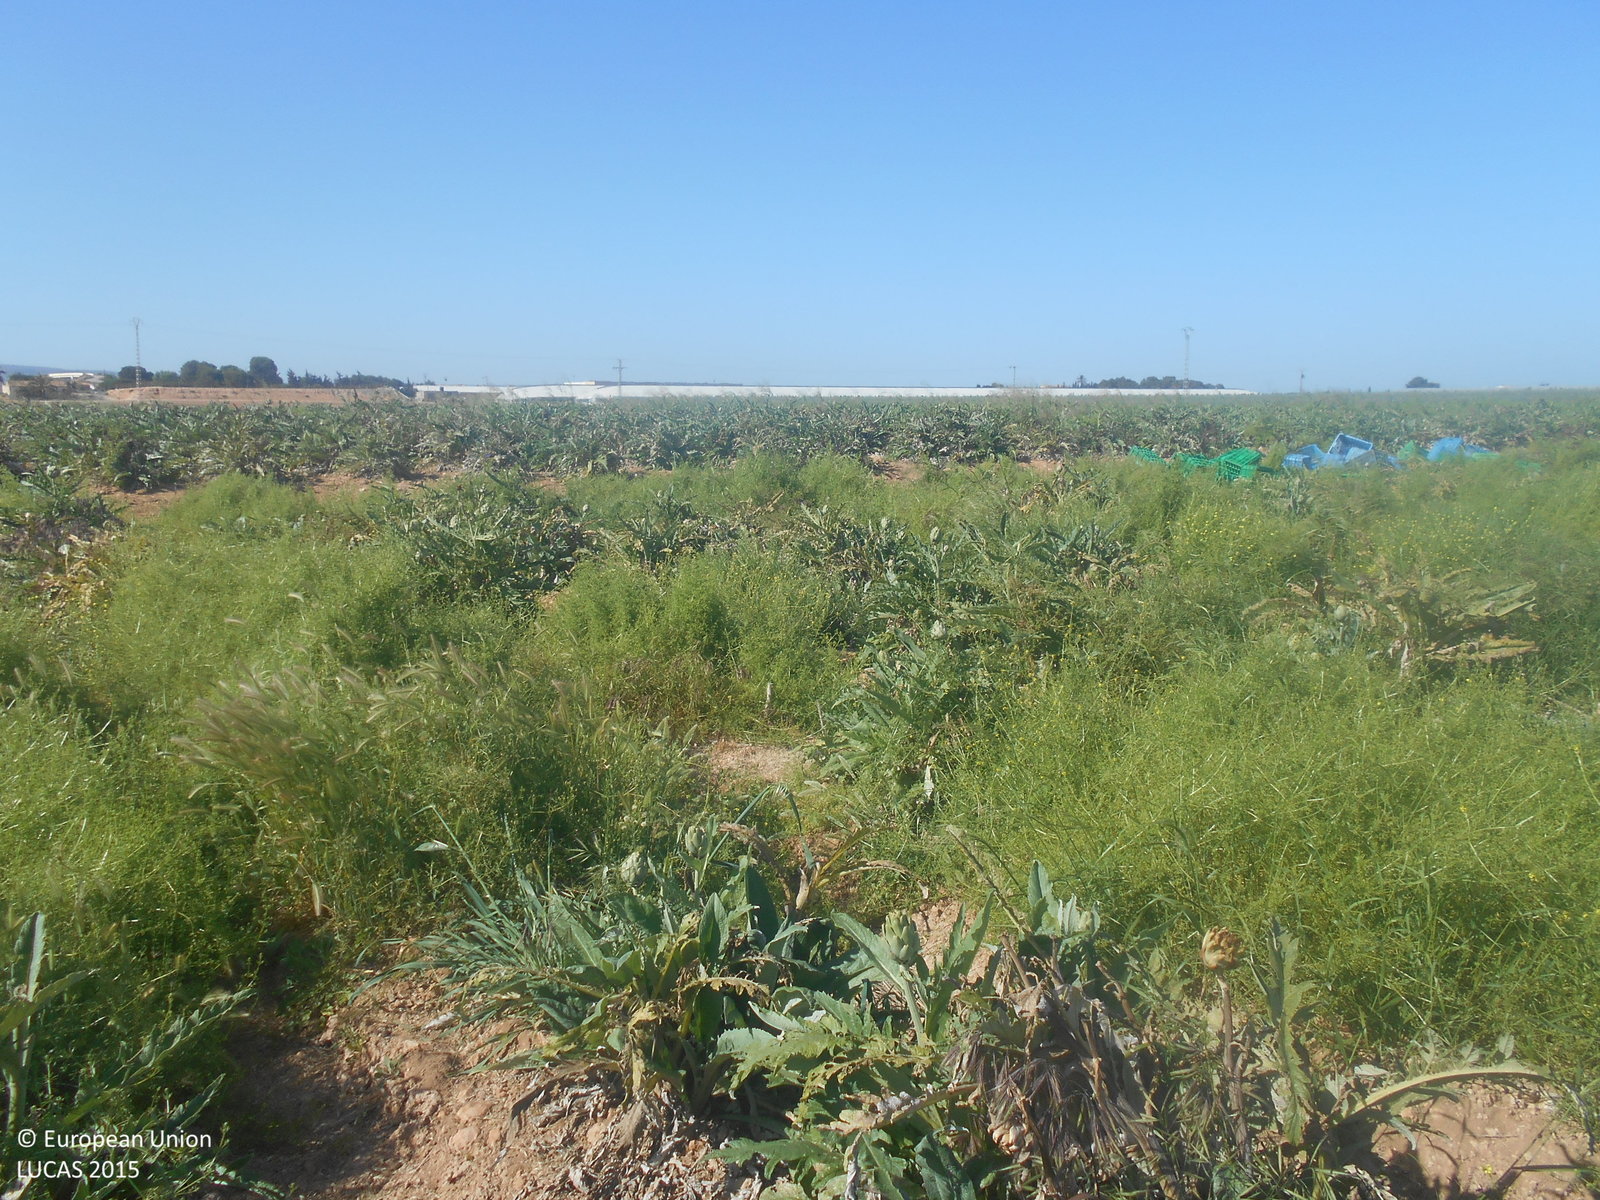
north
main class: Cropland
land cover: Other fresh vegetables
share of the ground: 25 - 50 %
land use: Agriculture (excluding fallow land and kitchen gardens)
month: May
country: ES
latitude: 37.8269
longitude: -0.9447
